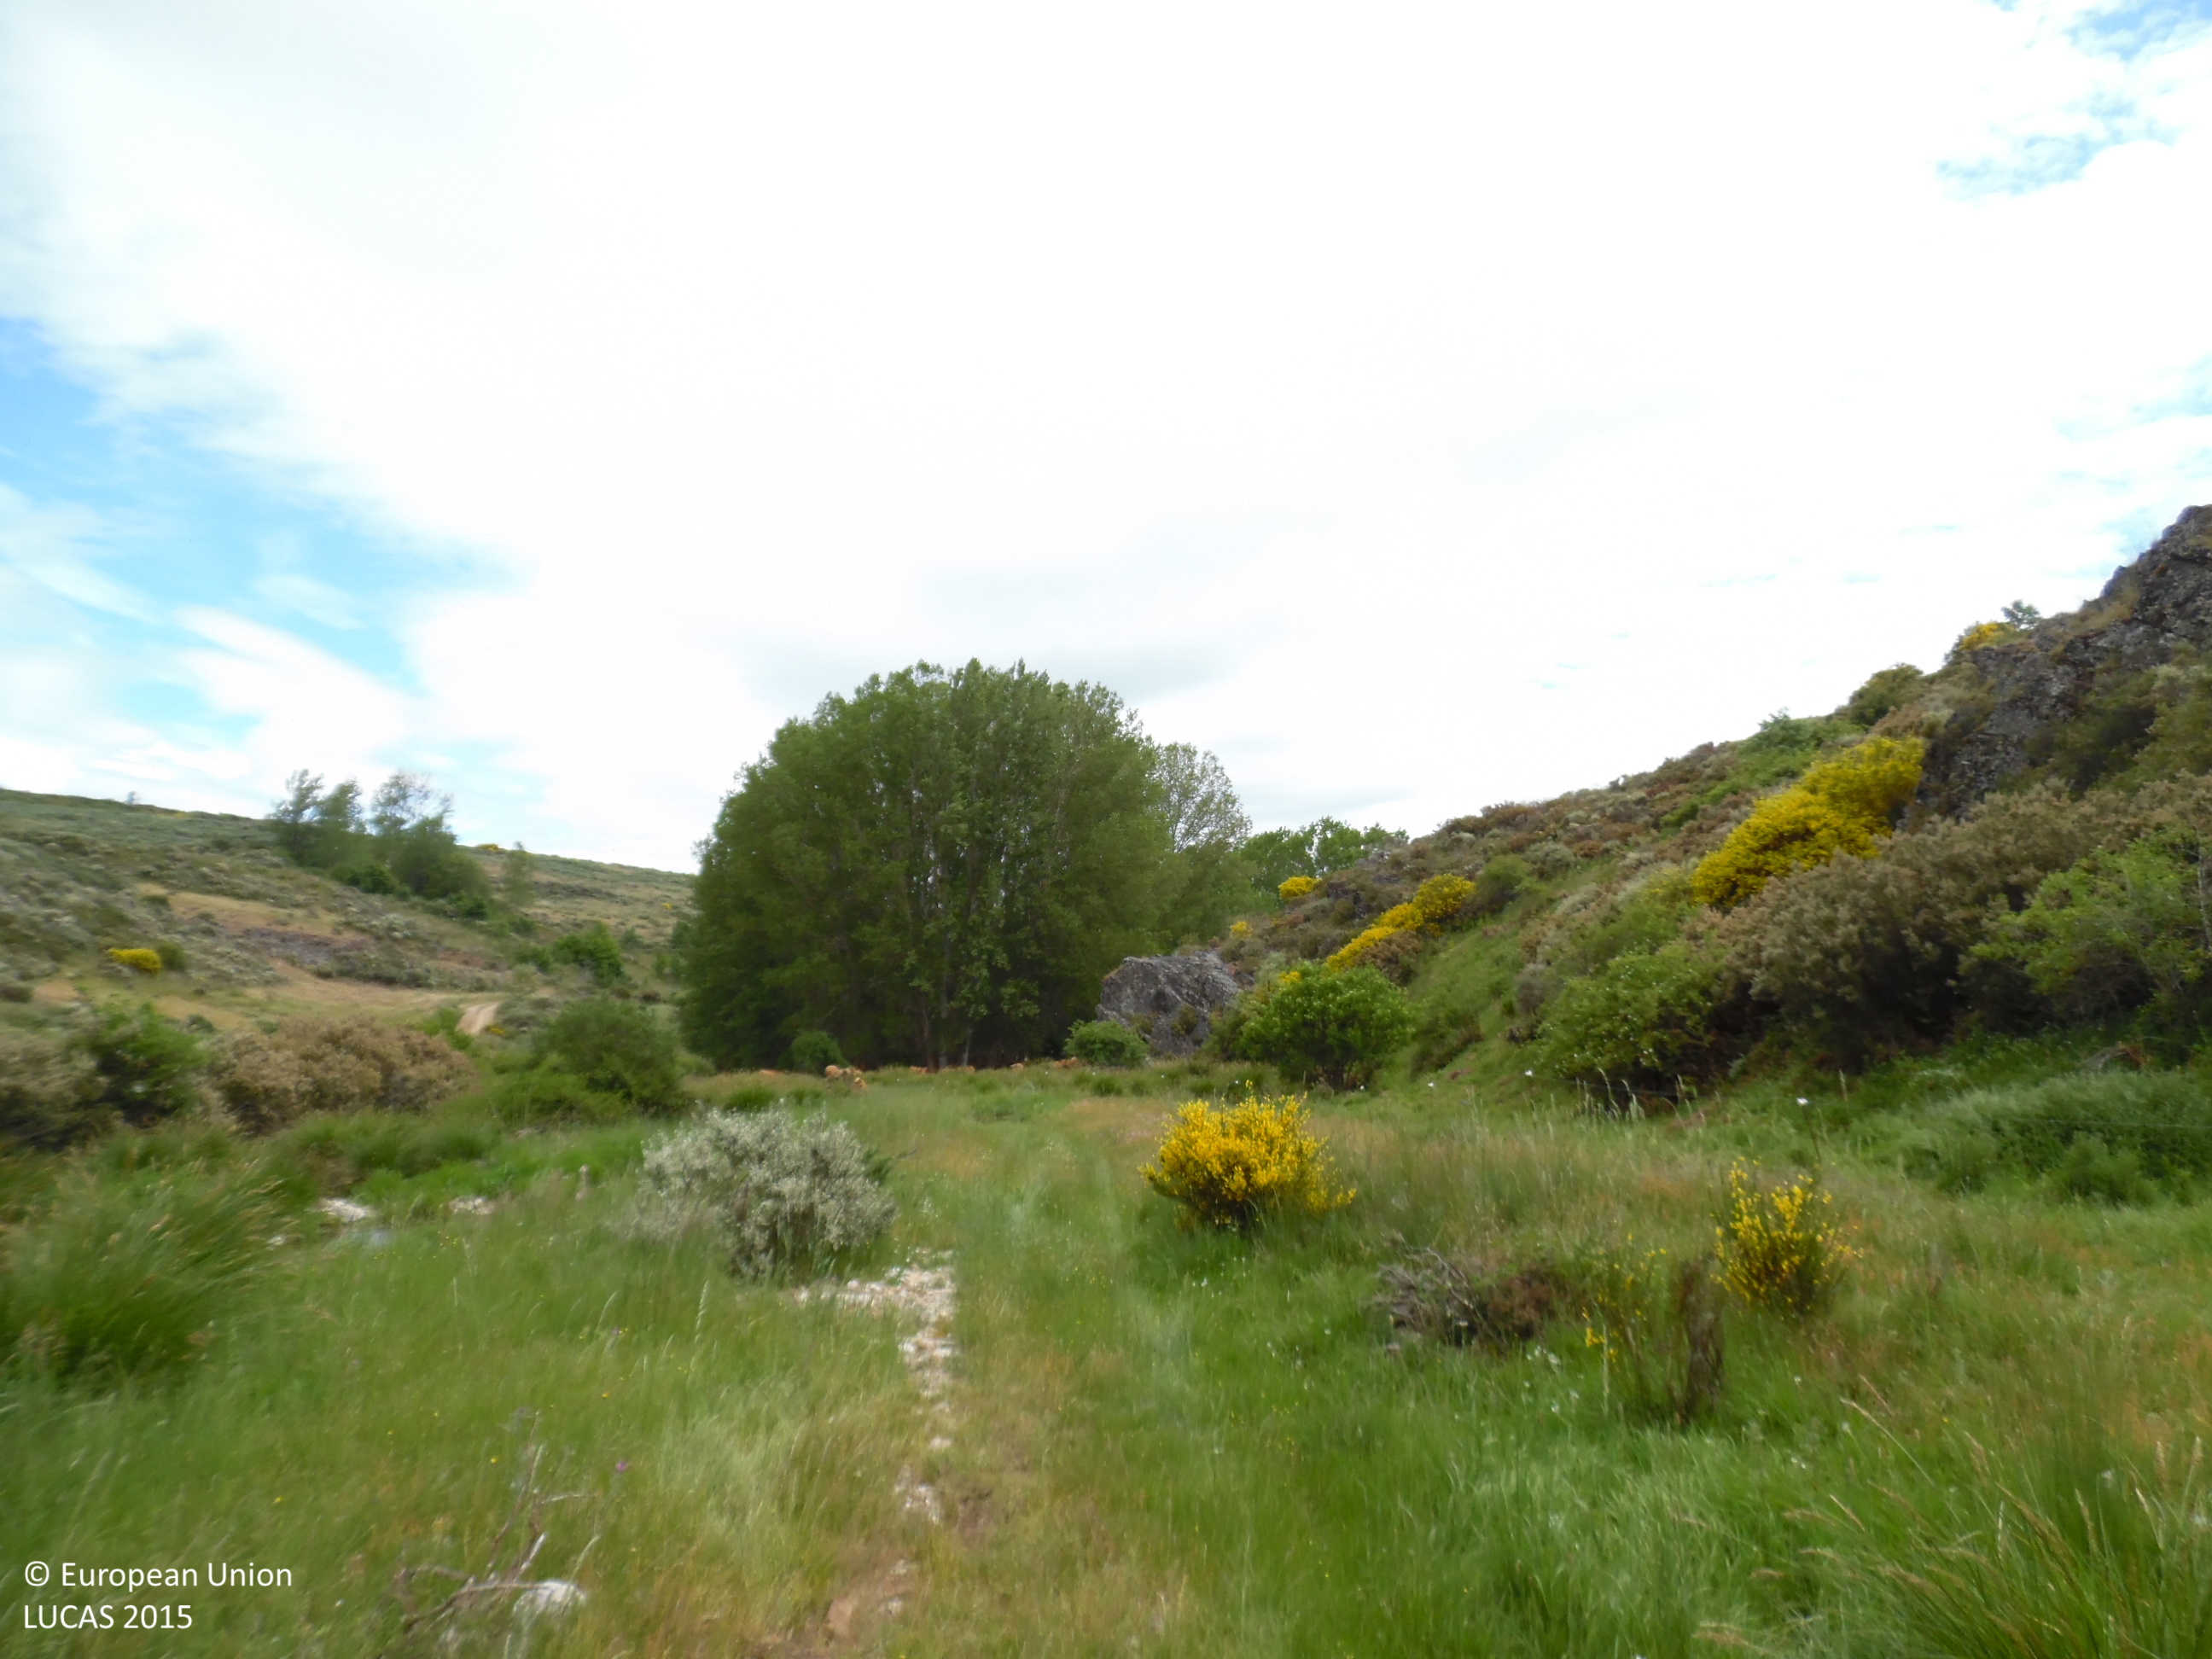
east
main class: Shrubland
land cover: Shrubland with sparse tree cover
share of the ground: > 75 %
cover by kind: shrubs 95 %, broadleaved forest trees 5 %
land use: Semi-natural and natural areas not in use
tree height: > 5 m
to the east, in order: Shrubland with sparse tree cover; Broadleaved woodland; Shrubland with sparse tree cover; Shrubland without tree cover
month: May
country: ES
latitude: 42.4556
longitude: -6.3459
